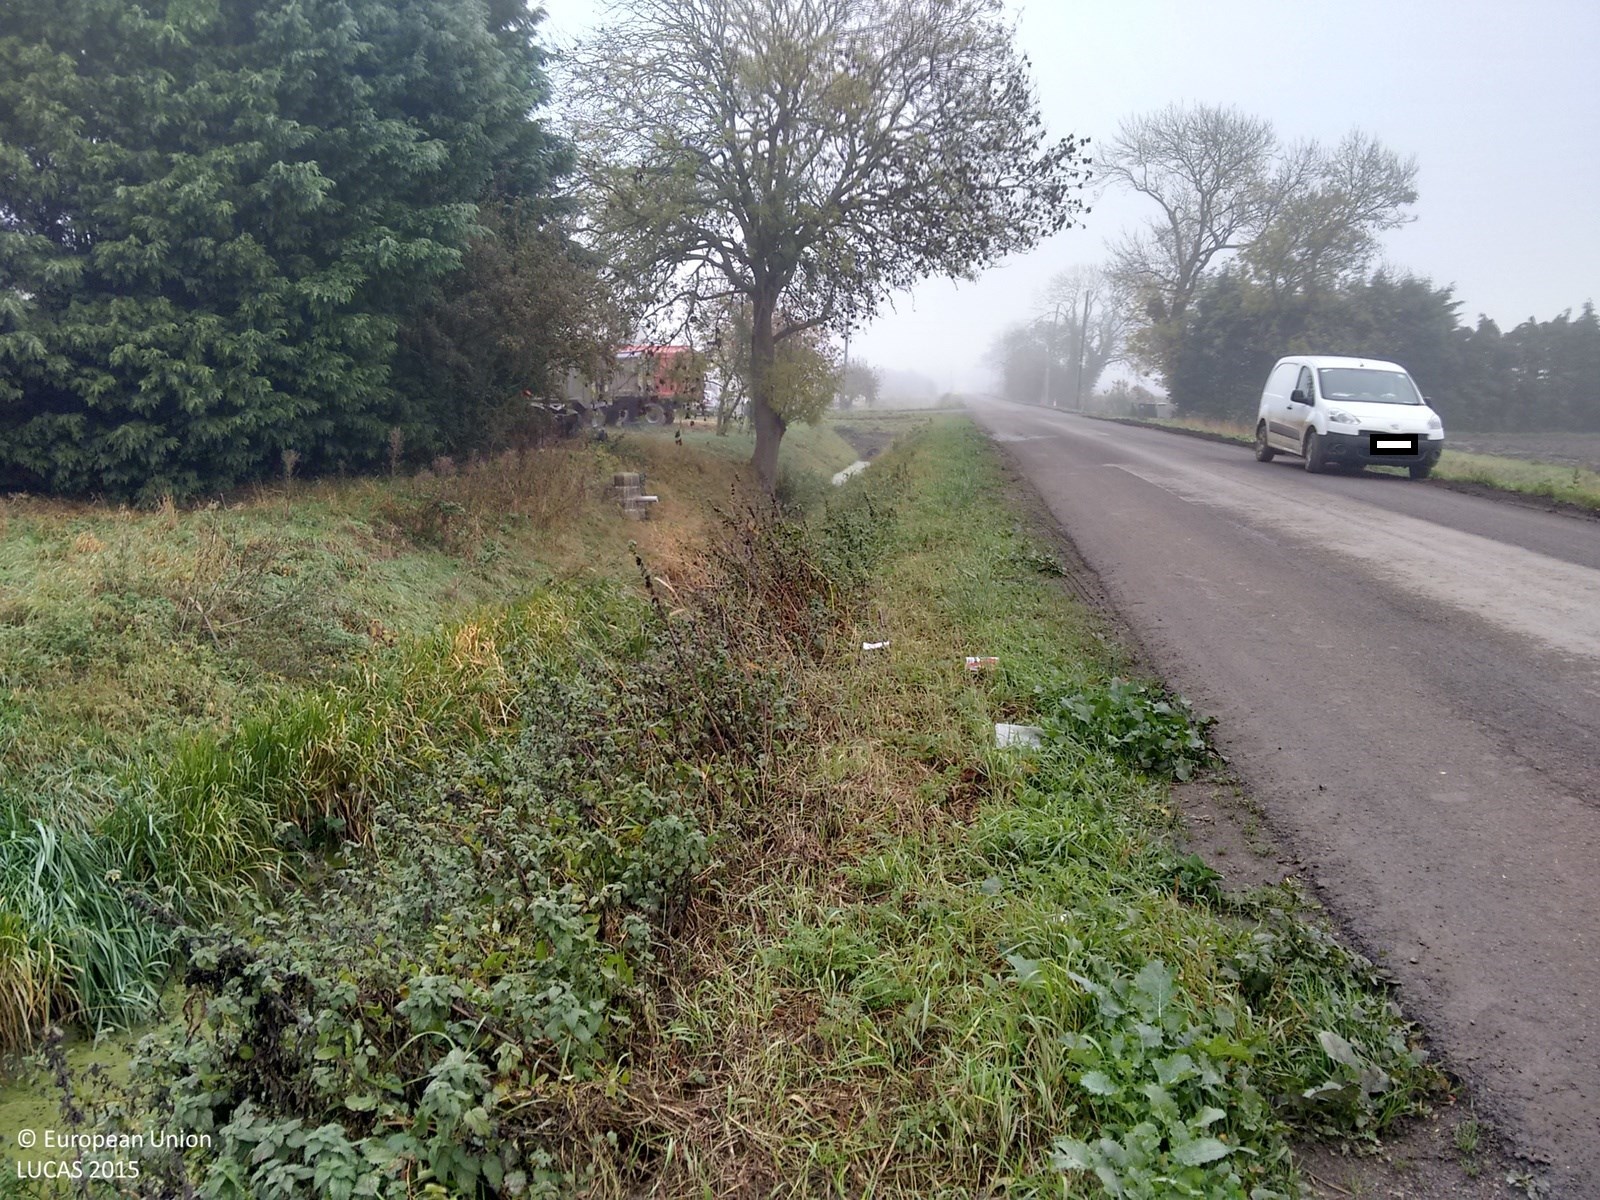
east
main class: Cropland
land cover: Maize
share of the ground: > 75 %
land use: Agriculture (excluding fallow land and kitchen gardens)
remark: Harvested field
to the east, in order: Maize; Artificial constructions in urban areas; Maize
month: November
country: GB
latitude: 53.0939
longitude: -0.0225
